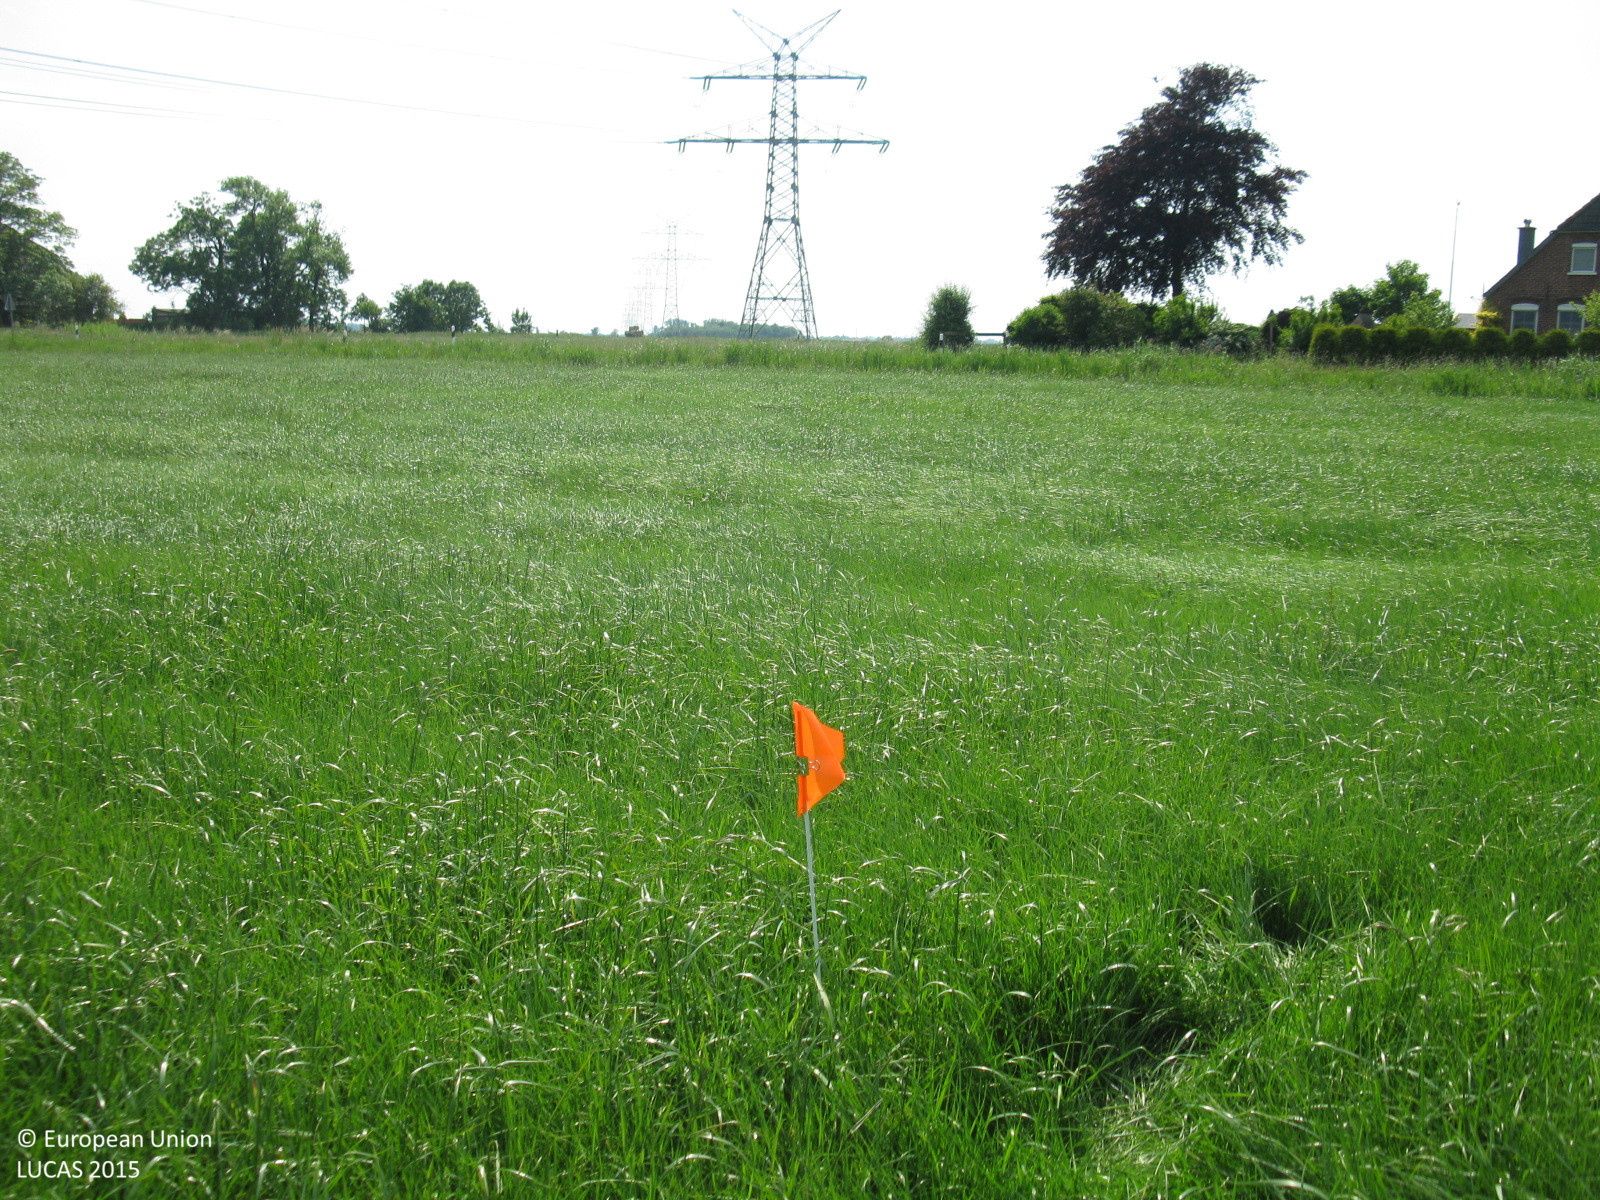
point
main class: Grassland
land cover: Grassland without tree/shrub cover
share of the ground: > 75 %
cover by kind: herbaceous plants 100 %
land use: Agriculture (excluding fallow land and kitchen gardens)
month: June
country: DE
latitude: 53.4276
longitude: 8.4204
